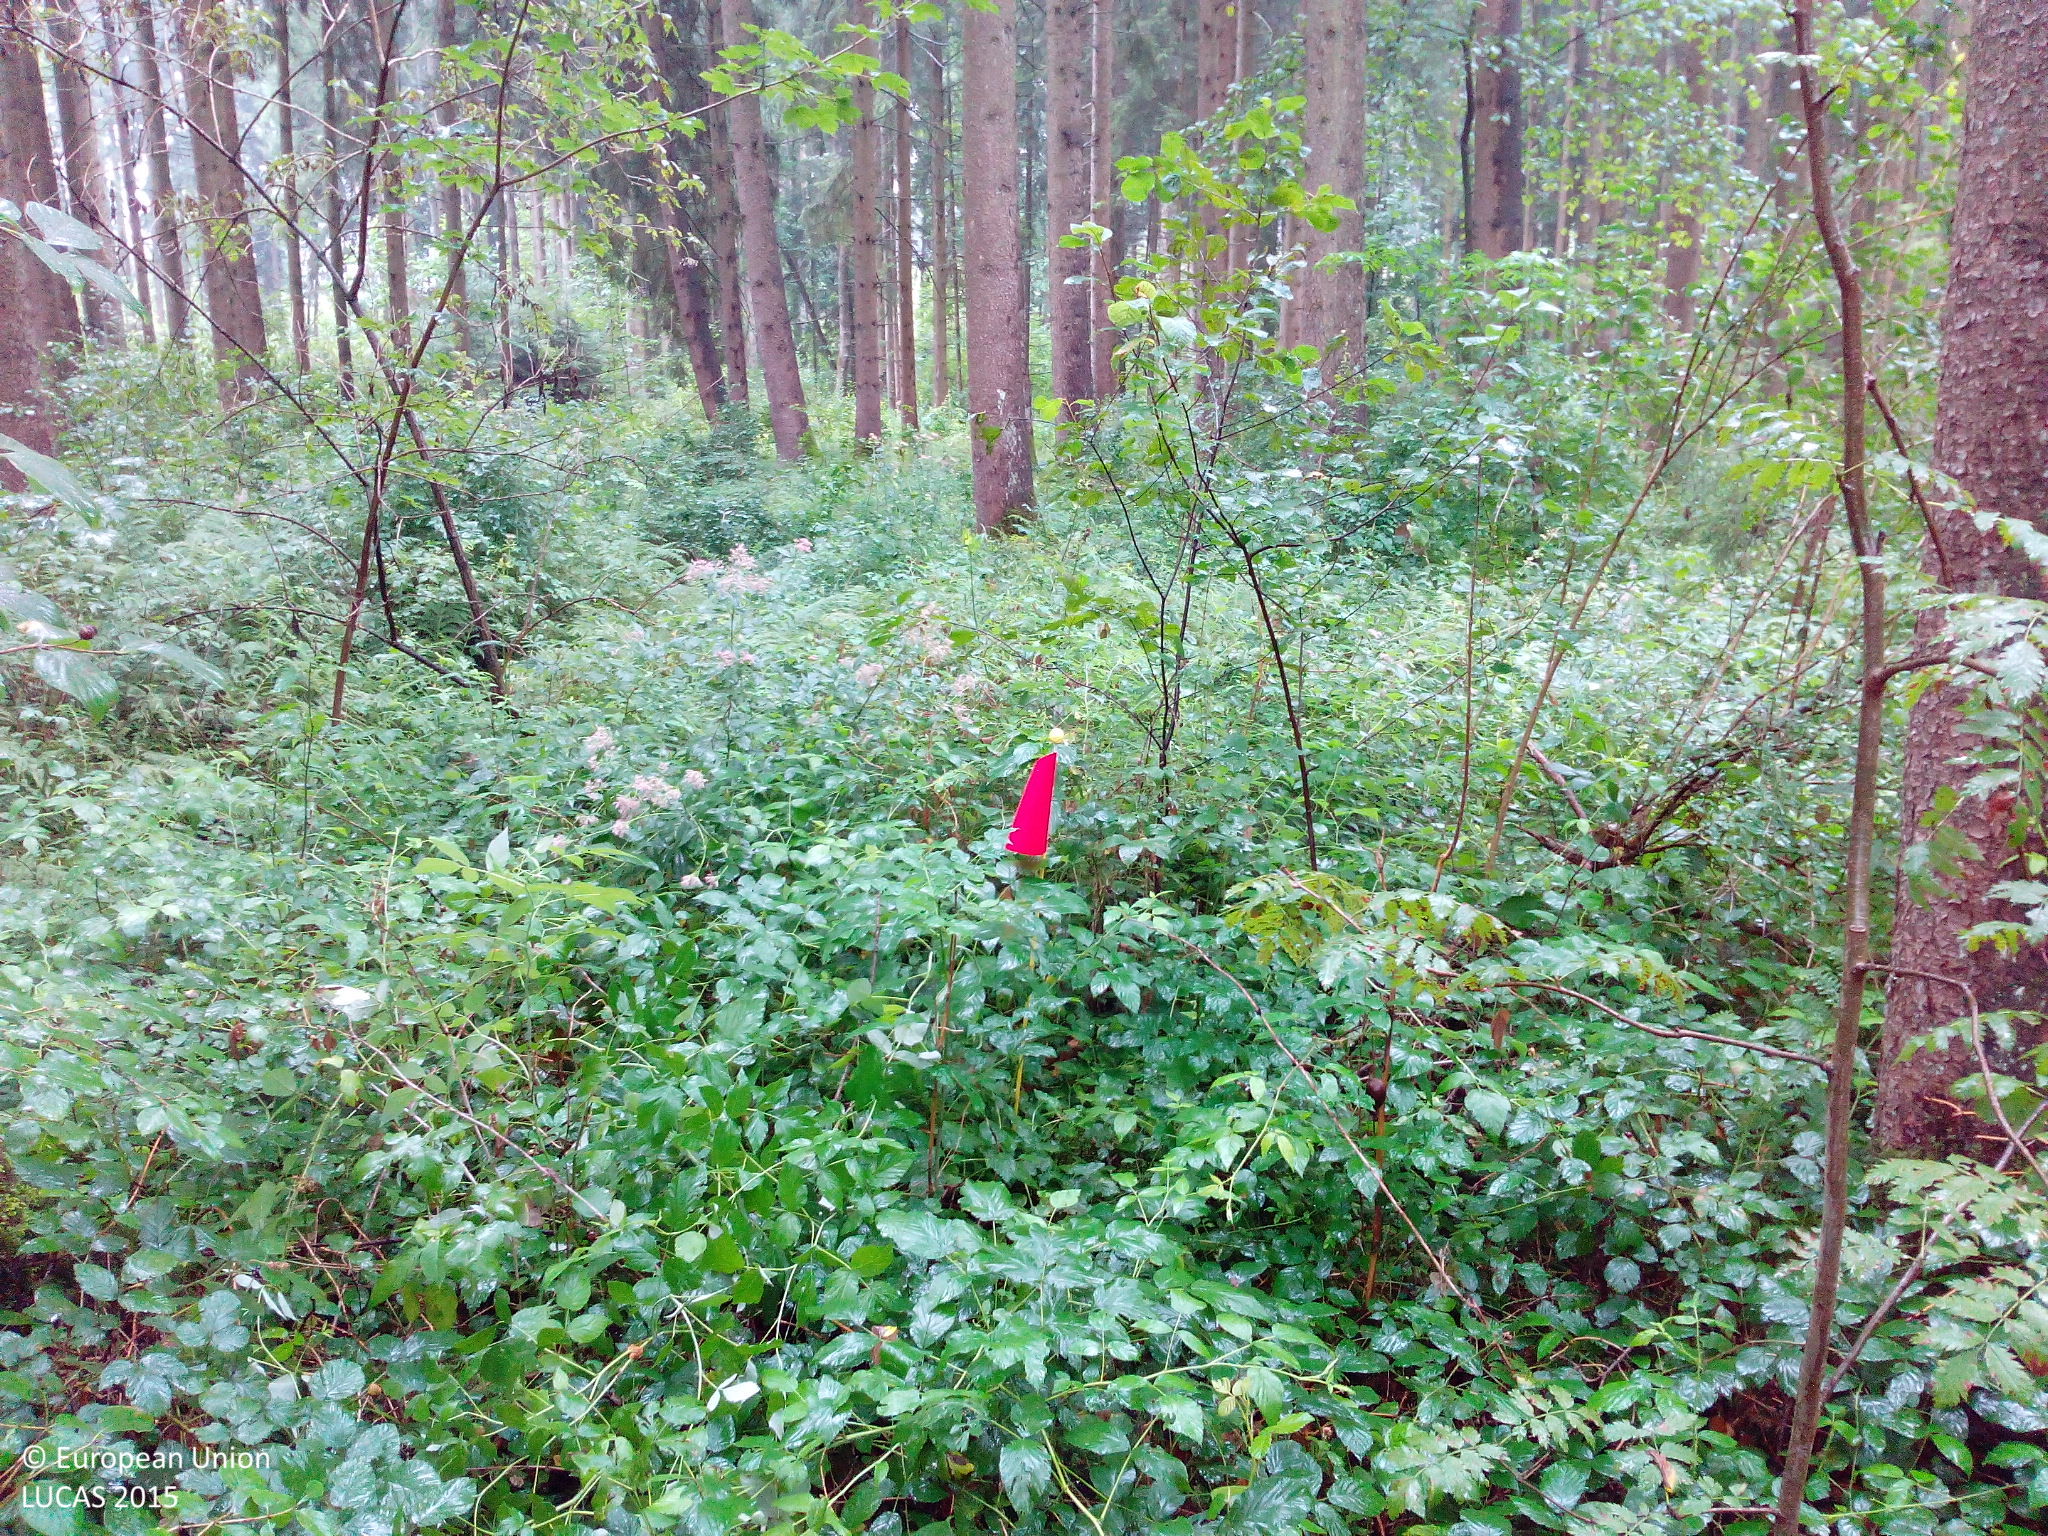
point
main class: Woodland
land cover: Spruce dominated coniferous woodland
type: hemiboreal forest and nemoral coniferous forest and mixed broadleaved-coniferous forest
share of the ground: > 75 %
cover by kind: coniferous forest trees 75 %, shrubs 20 %, broadleaved forest trees 5 %
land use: Forestry
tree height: > 5 m
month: August
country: DE
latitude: 47.8980
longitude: 12.8746
